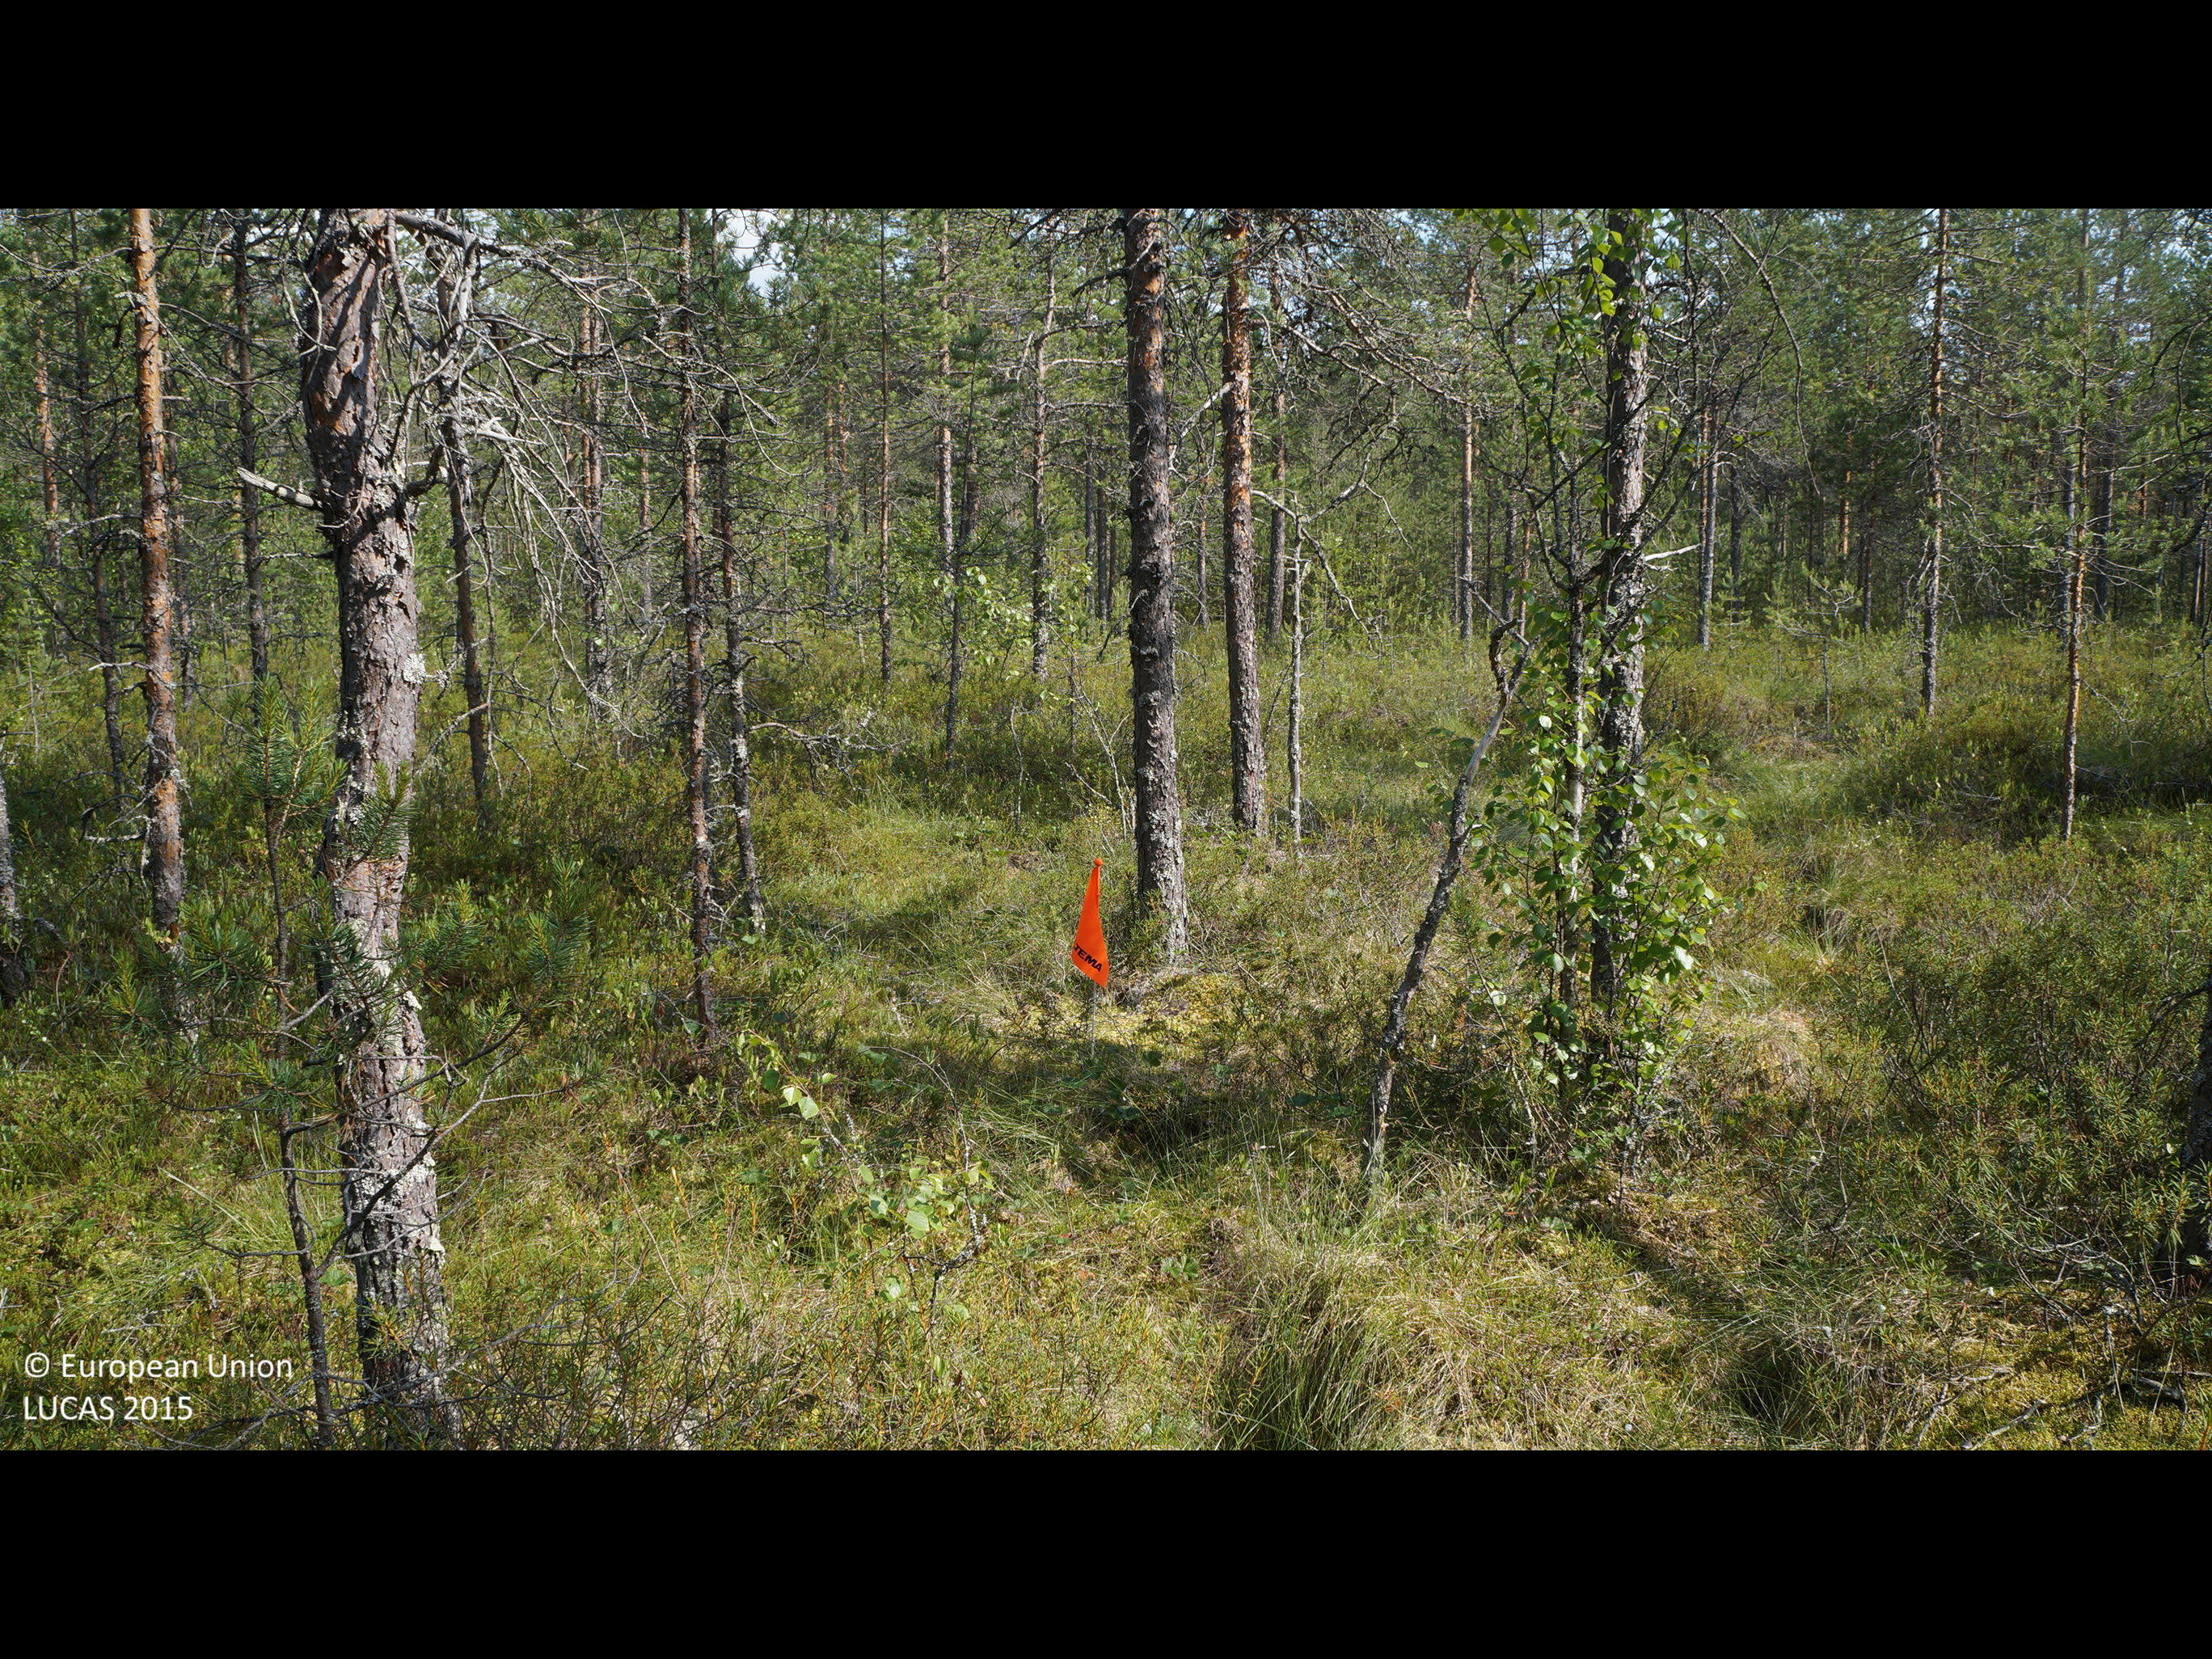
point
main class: Woodland
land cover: Pine dominated coniferous woodland
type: boreal forest
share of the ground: 25 - 50 %
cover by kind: coniferous forest trees 40 %, shrubs 40 %, lichens and mosses 20 %
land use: Forestry
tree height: > 5 m
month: July
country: FI
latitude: 64.4490
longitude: 24.4695
